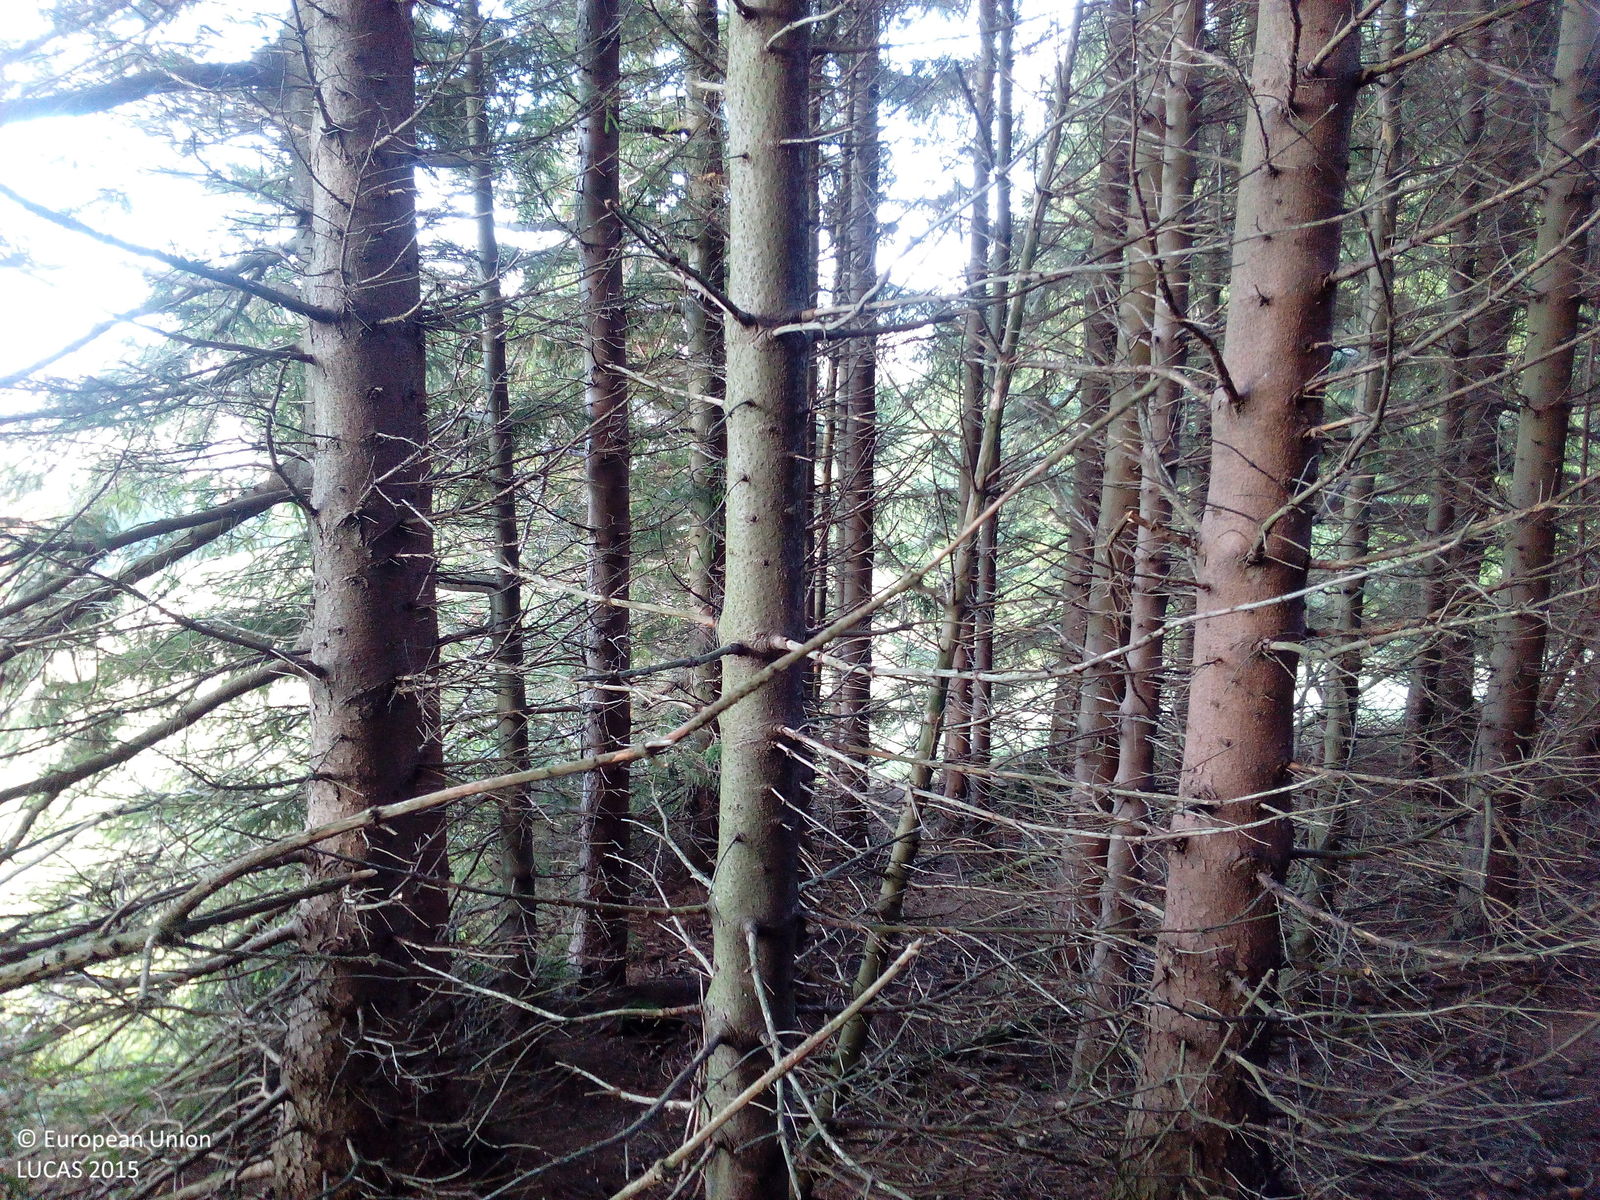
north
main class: Woodland
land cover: Spruce dominated coniferous woodland
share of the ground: > 75 %
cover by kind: coniferous forest trees 80 %, consolidated bare surface 15 %, lichens and mosses 5 %
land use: Forestry
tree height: > 5 m
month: October
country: DE
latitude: 50.4000
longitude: 9.9578
